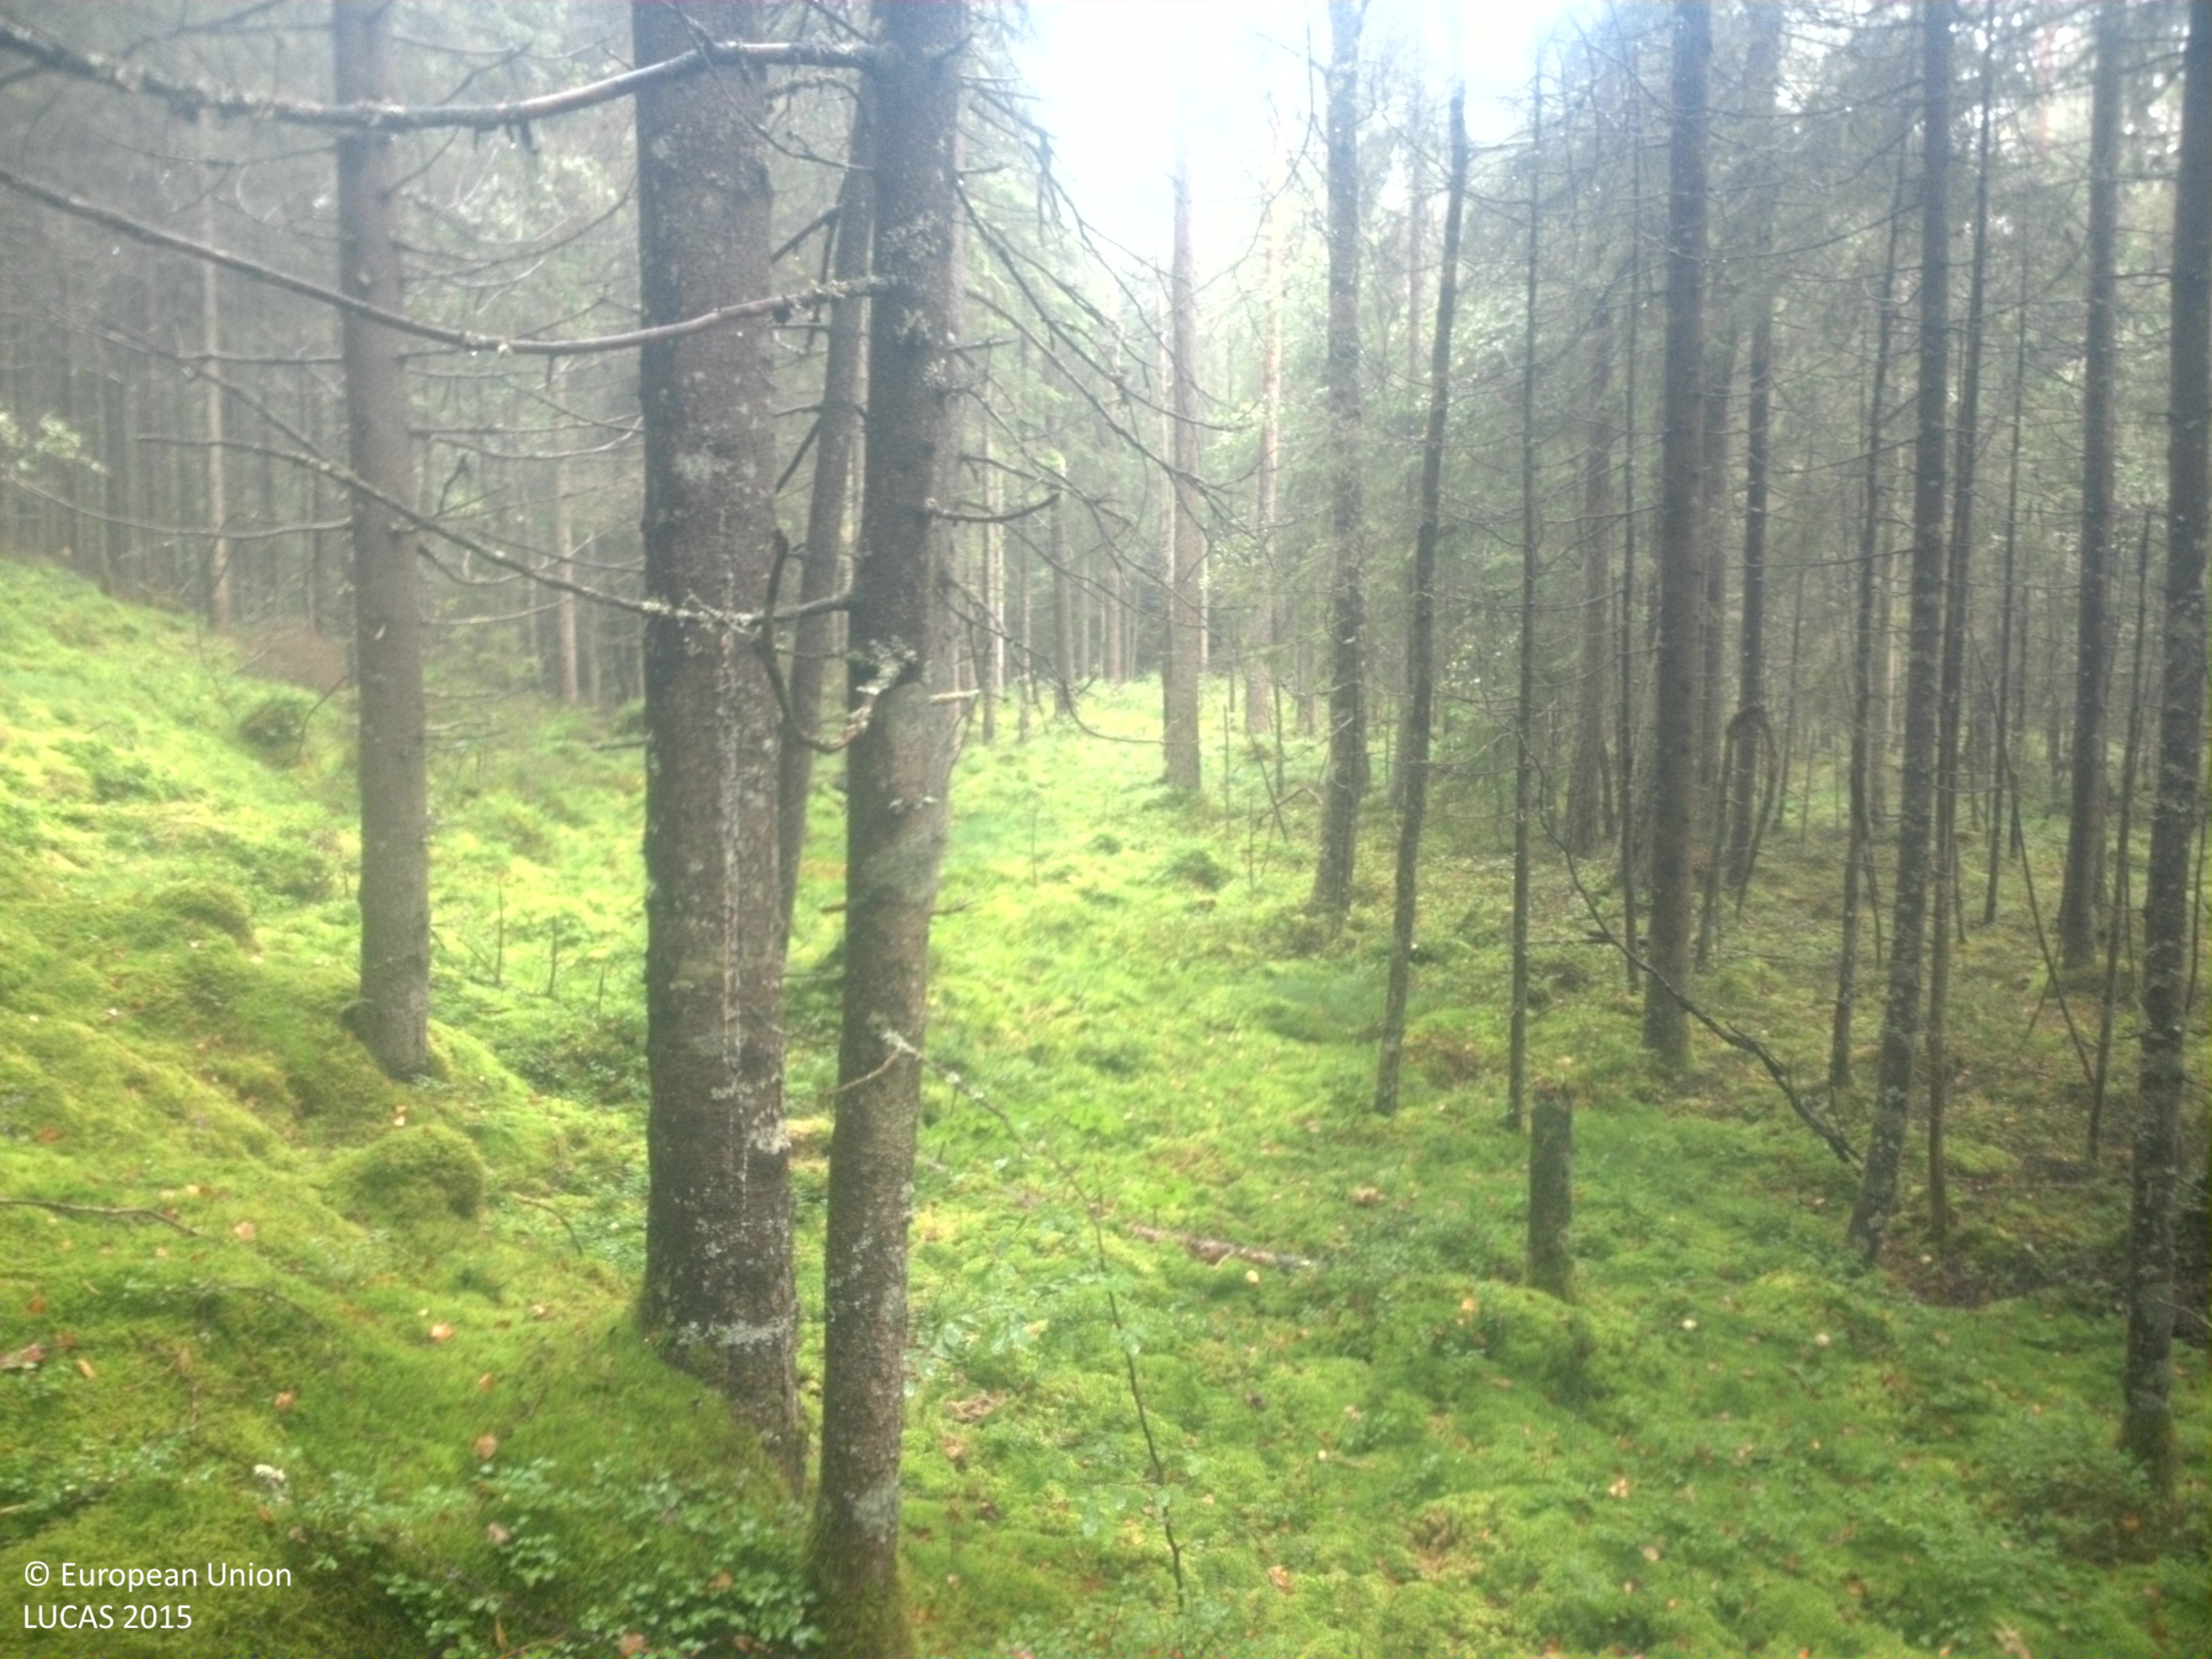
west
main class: Woodland
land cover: Spruce dominated coniferous woodland
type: boreal forest
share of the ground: 50 - 75 %
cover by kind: coniferous forest trees 50 %, lichens and mosses 50 %
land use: Forestry
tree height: > 5 m
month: August
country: SE
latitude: 57.7126
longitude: 13.2348
